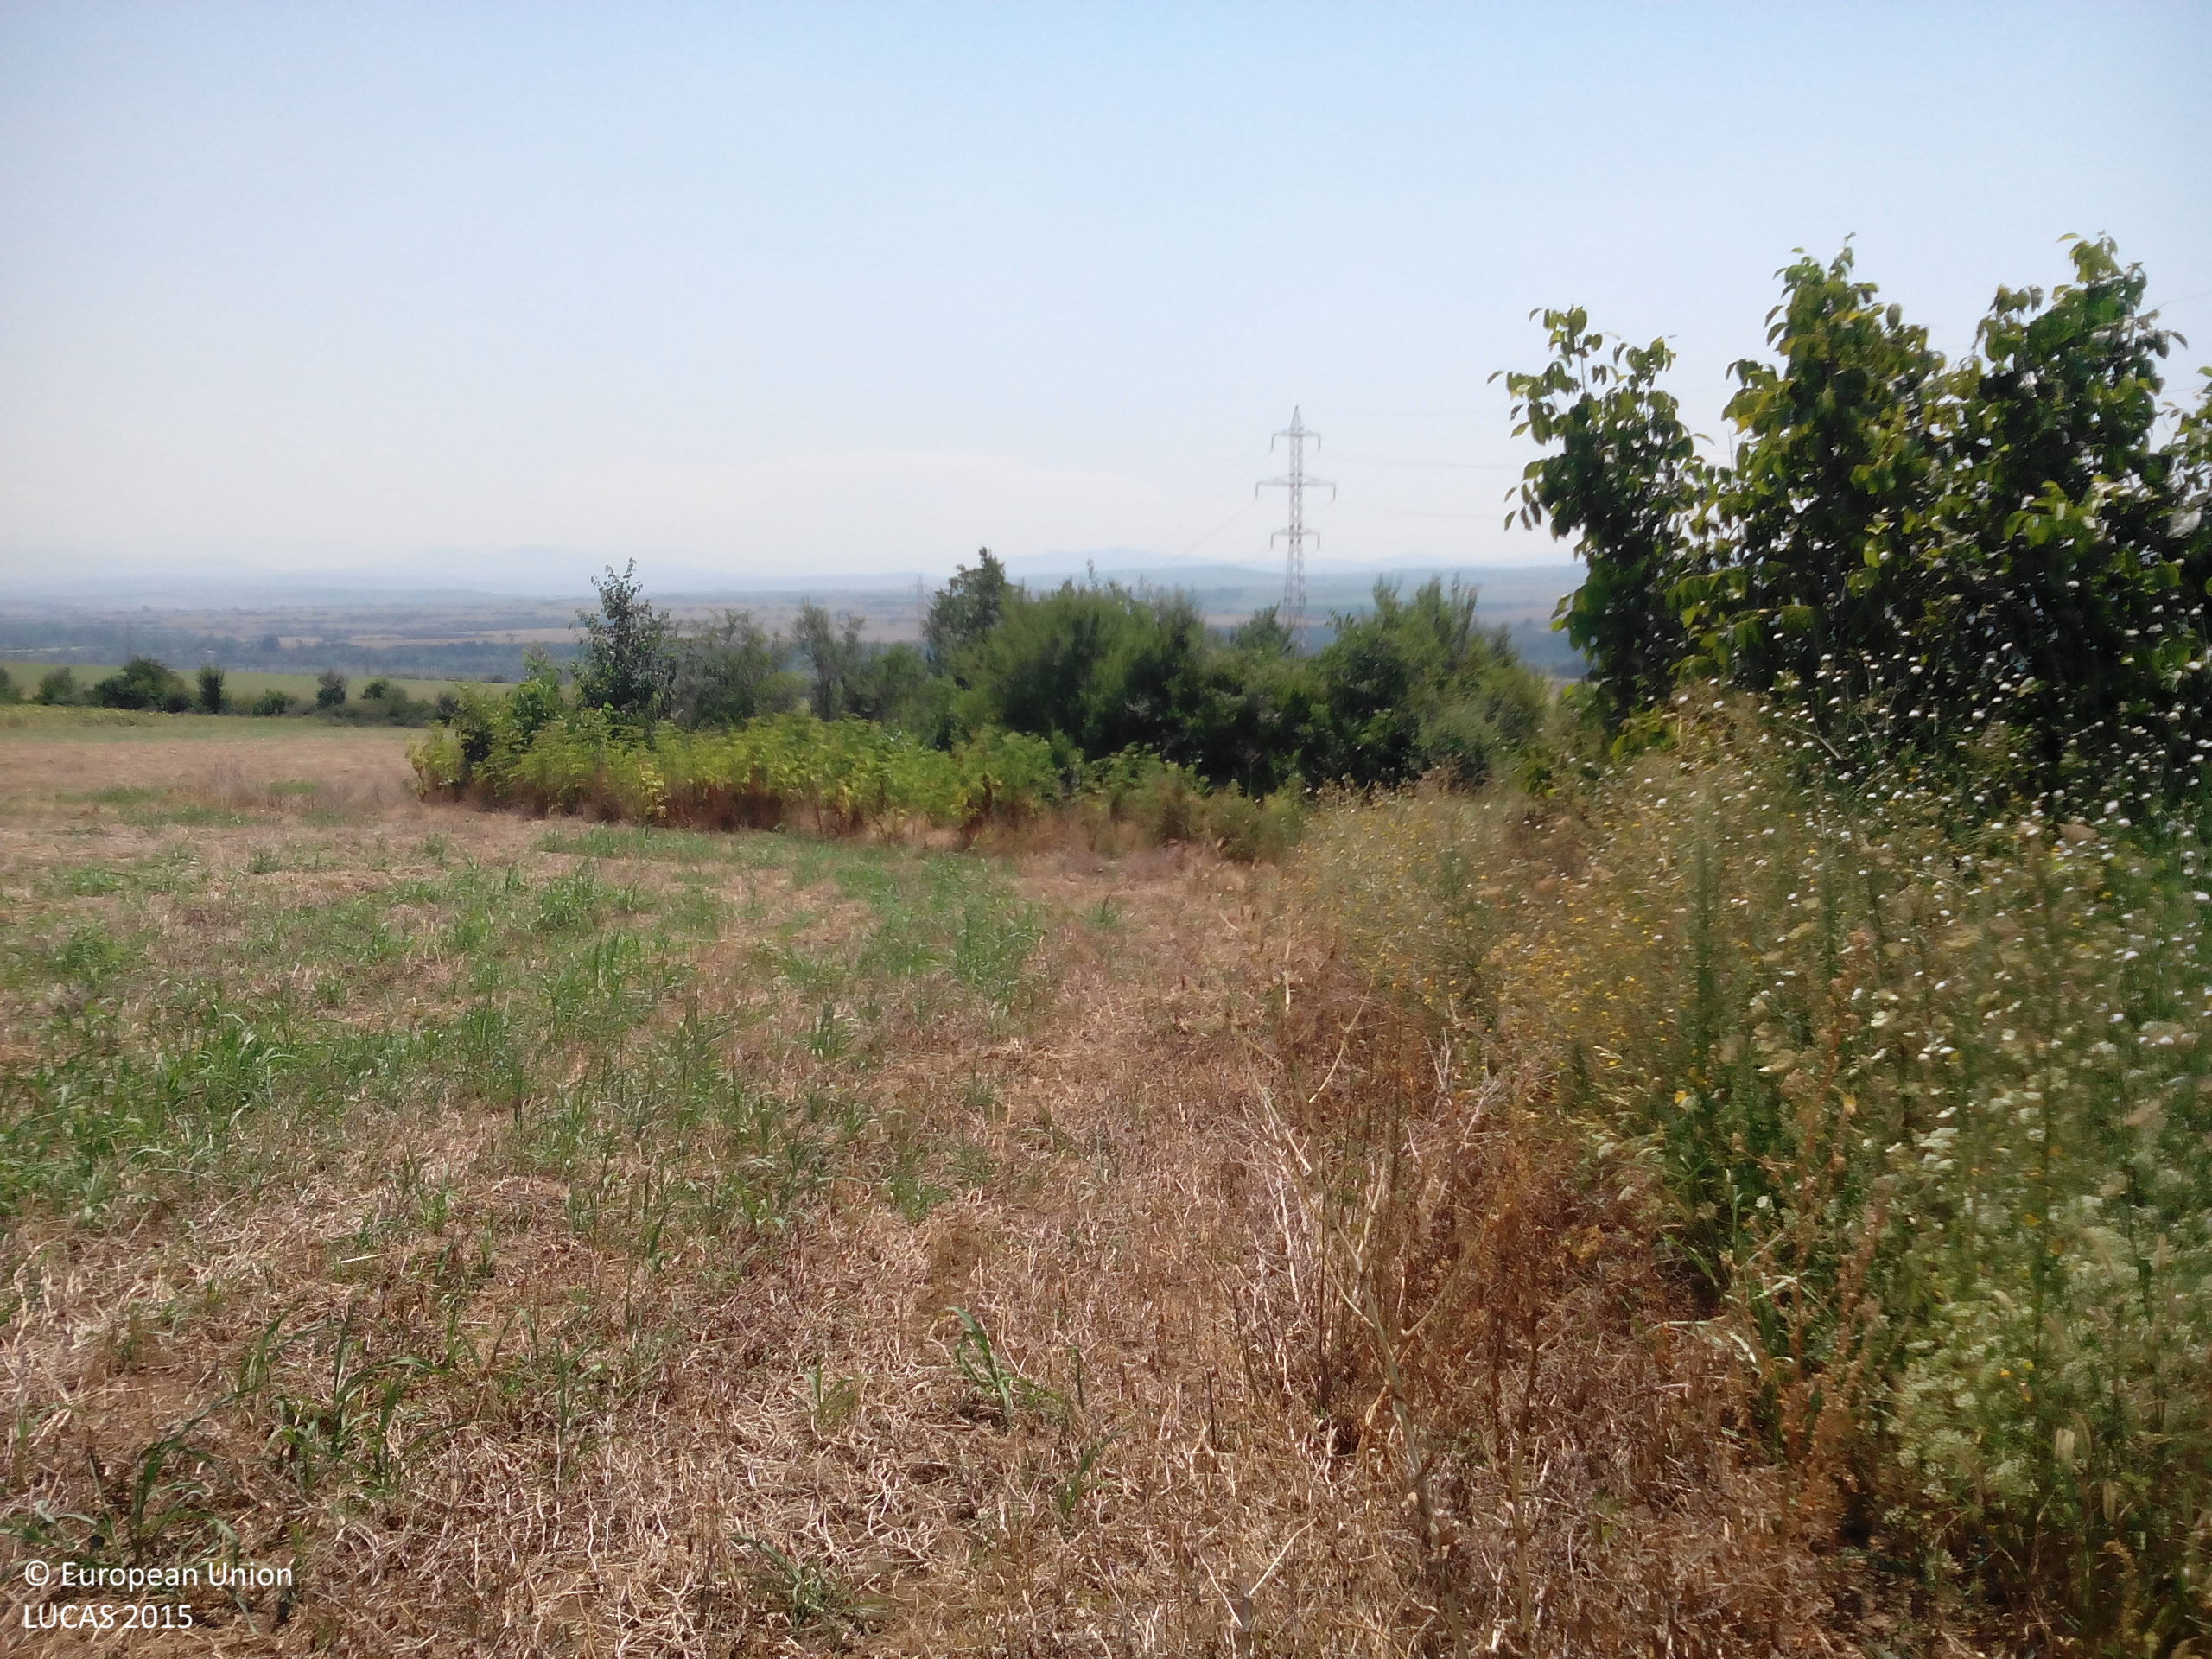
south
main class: Cropland
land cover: Dry pulses
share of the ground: 25 - 50 %
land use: Agriculture (excluding fallow land and kitchen gardens)
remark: Harvested field
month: July
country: BG
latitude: 43.2819
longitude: 24.1635
